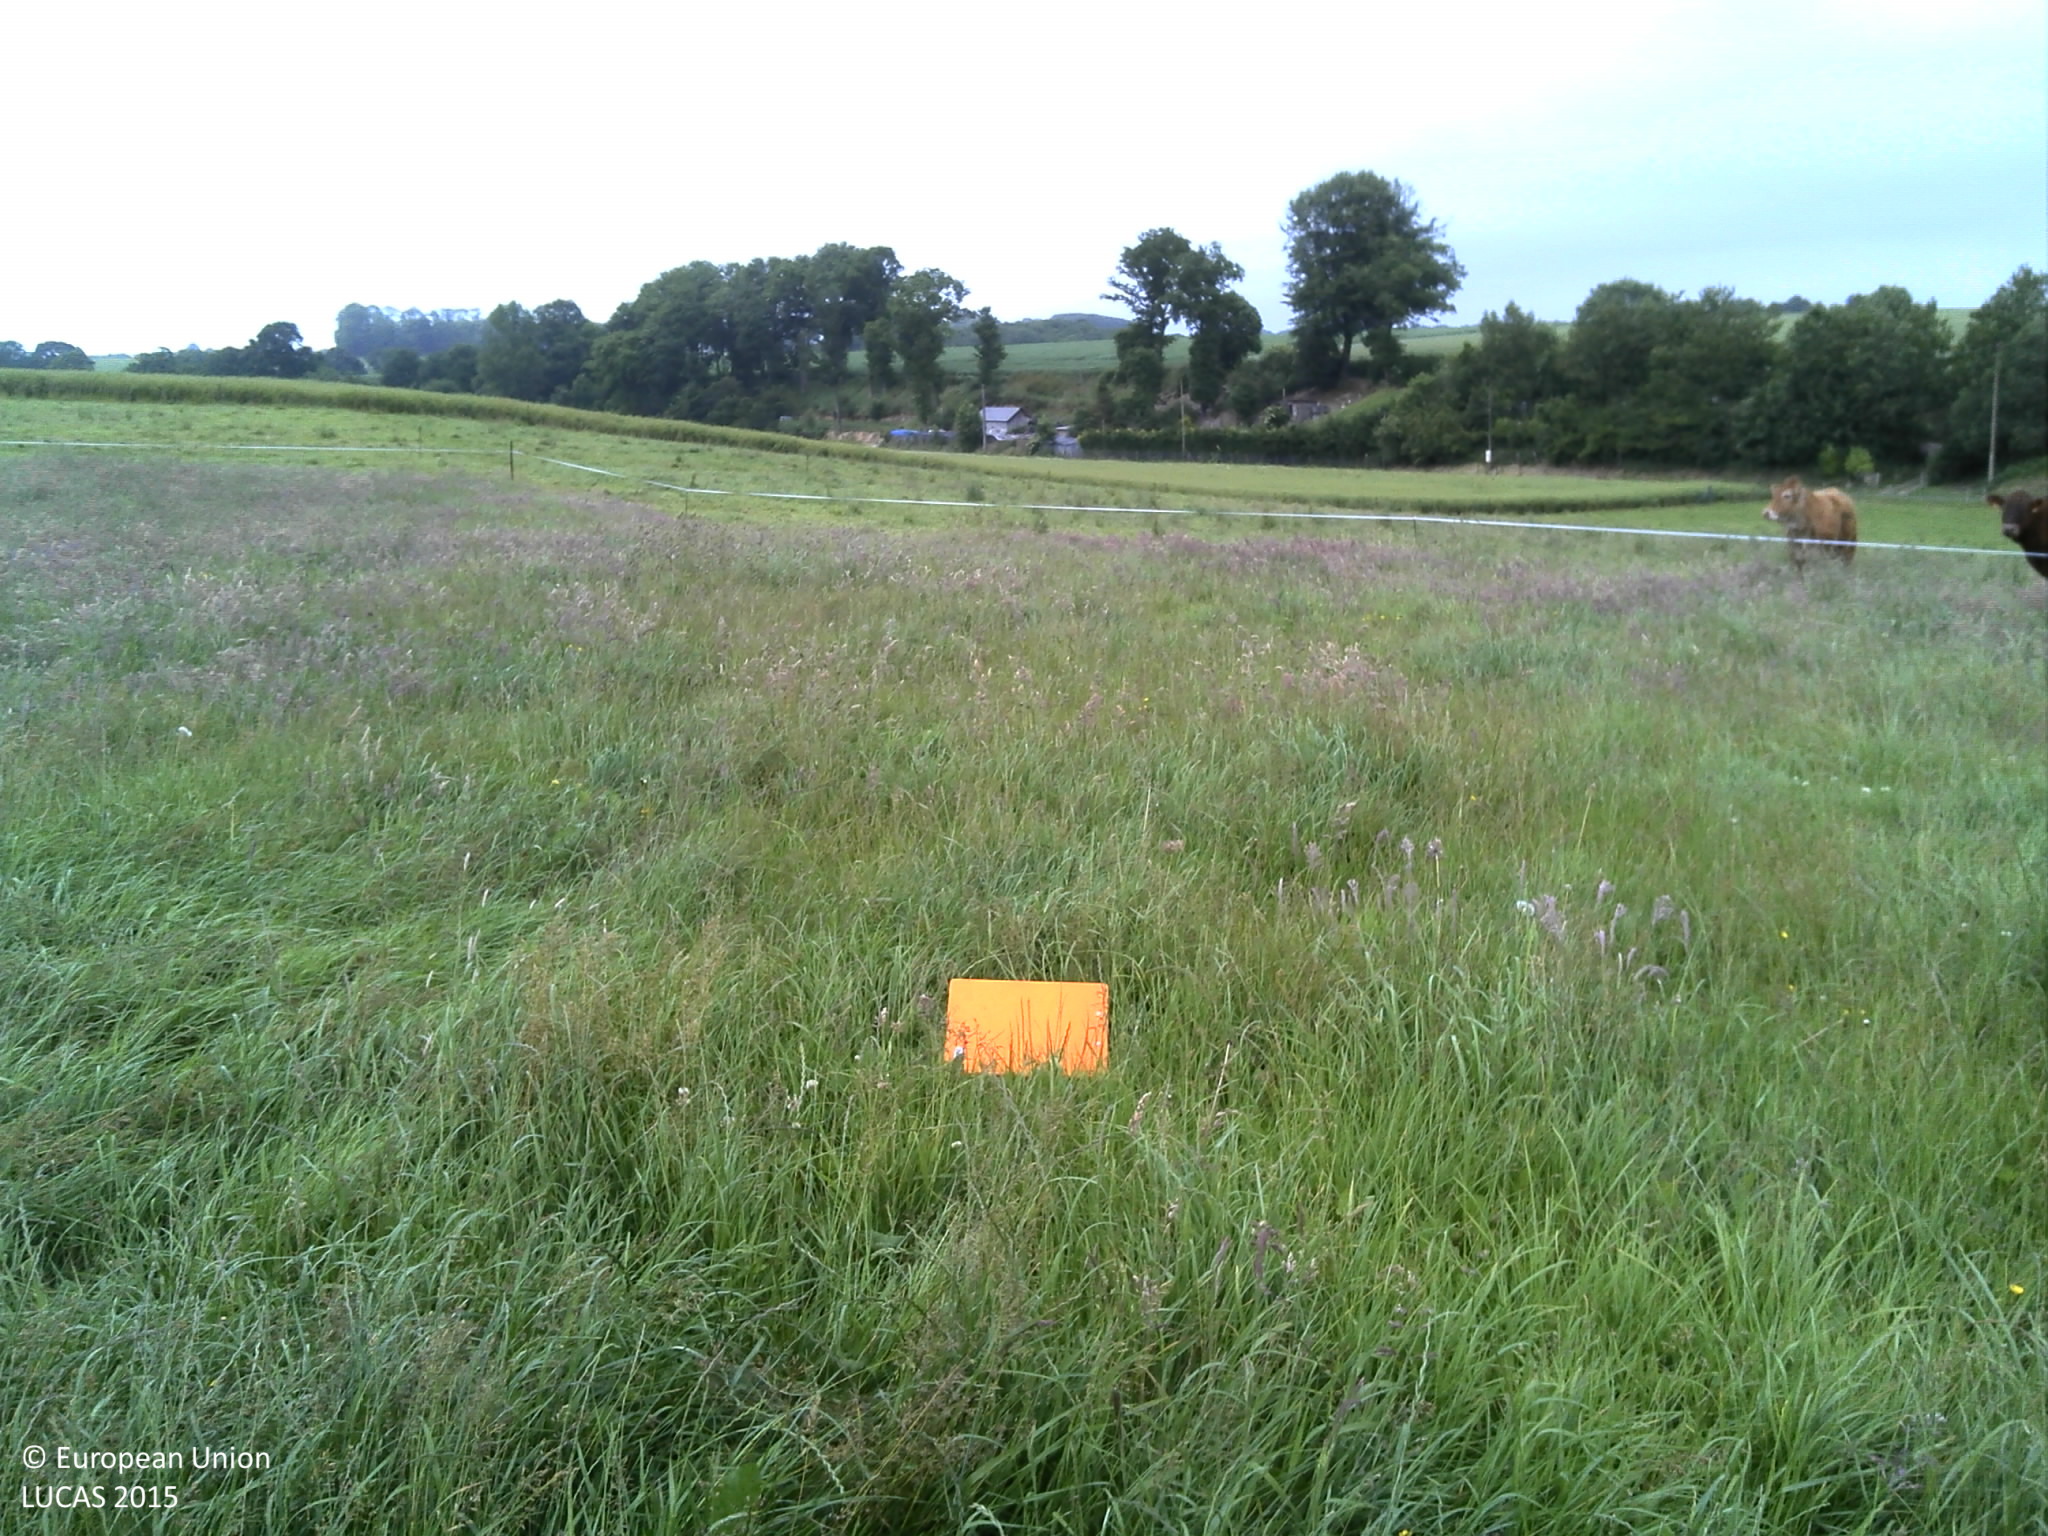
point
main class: Grassland
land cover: Grassland without tree/shrub cover
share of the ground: > 75 %
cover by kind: herbaceous plants 100 %
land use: Agriculture (excluding fallow land and kitchen gardens)
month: June
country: FR
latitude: 49.6834
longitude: 0.5627
